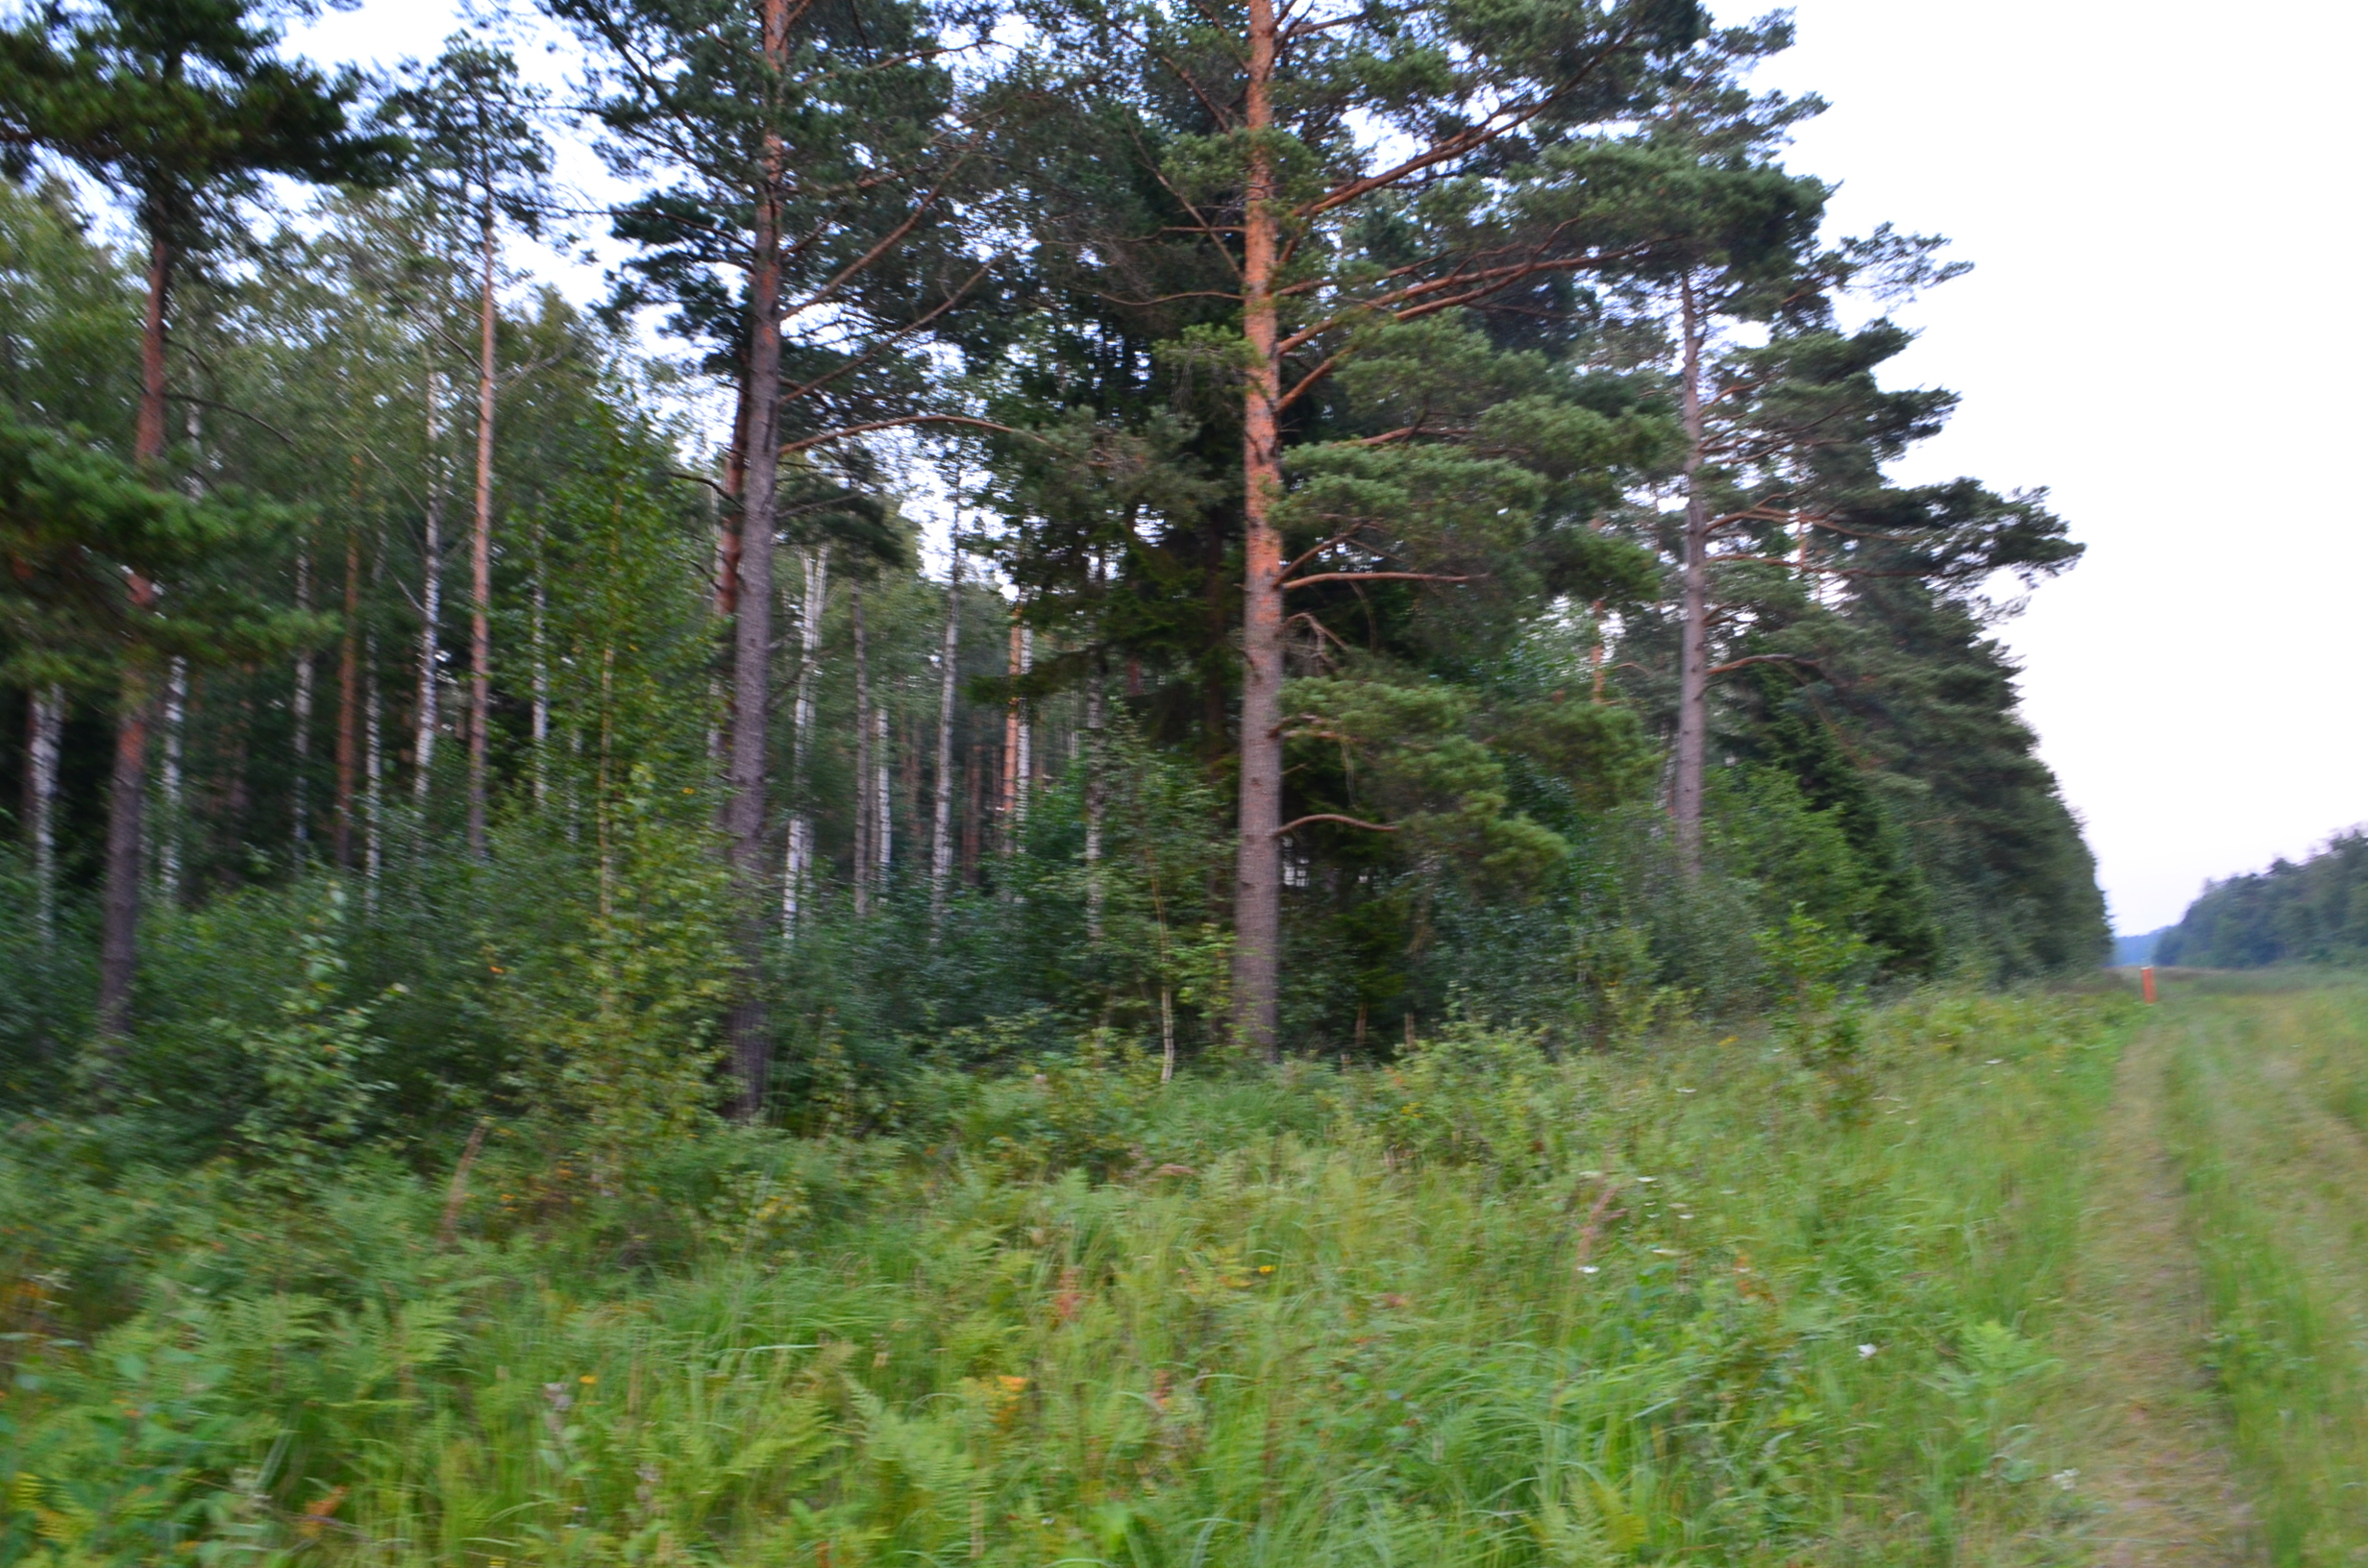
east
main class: Woodland
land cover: Pine dominated mixed woodland
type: hemiboreal forest and nemoral coniferous forest and mixed broadleaved-coniferous forest
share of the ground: > 75 %
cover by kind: broadleaved forest trees 55 %, coniferous forest trees 40 %, herbaceous plants 4 %, shrubs 1 %
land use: Forestry
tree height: > 5 m
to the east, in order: Tracks; Spontaneously vegetated surfaces; Pine dominated mixed woodland; Other mixed woodland; Pine dominated coniferous woodland
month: August
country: LV
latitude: 57.4200
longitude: 21.6460
